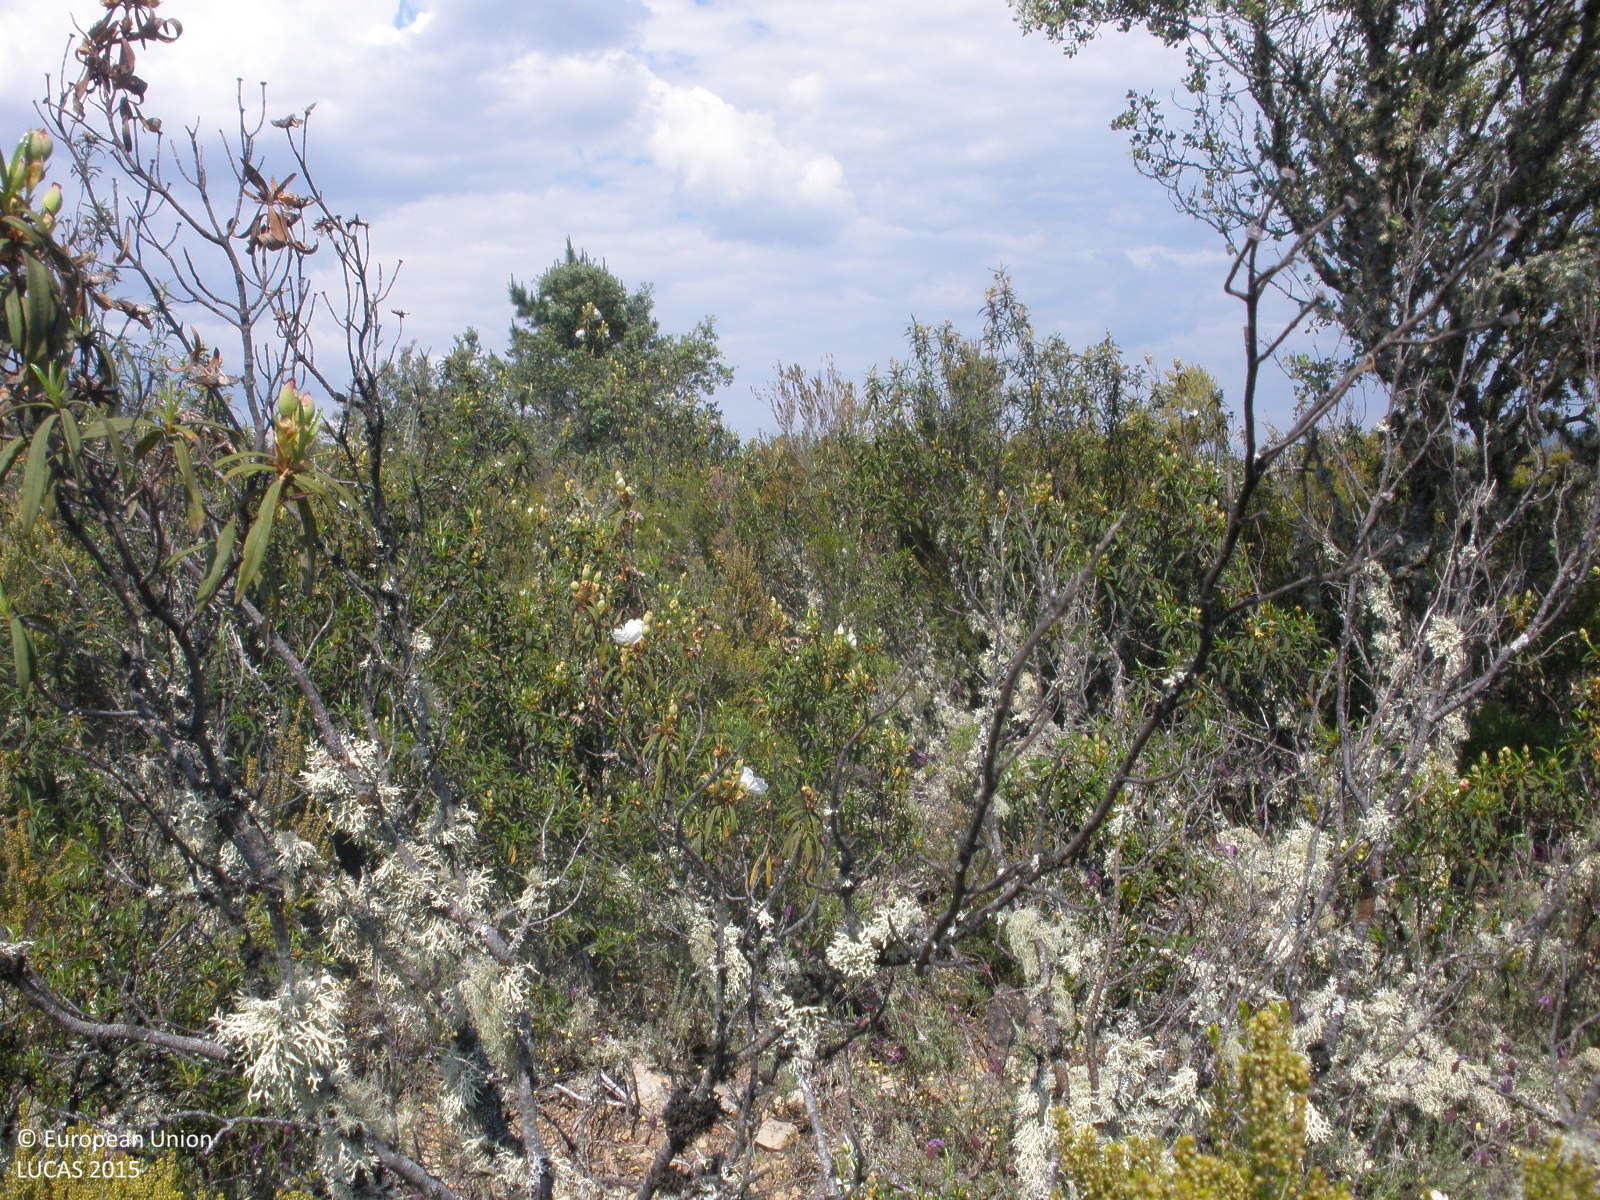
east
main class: Shrubland
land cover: Shrubland with sparse tree cover
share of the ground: > 75 %
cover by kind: shrubs 95 %, broadleaved forest trees 5 %
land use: Semi-natural and natural areas not in use
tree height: < 5 m
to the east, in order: Shrubland with sparse tree cover; Broadleaved woodland; Rye
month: June
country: ES
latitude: 40.5433
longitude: -6.3436
